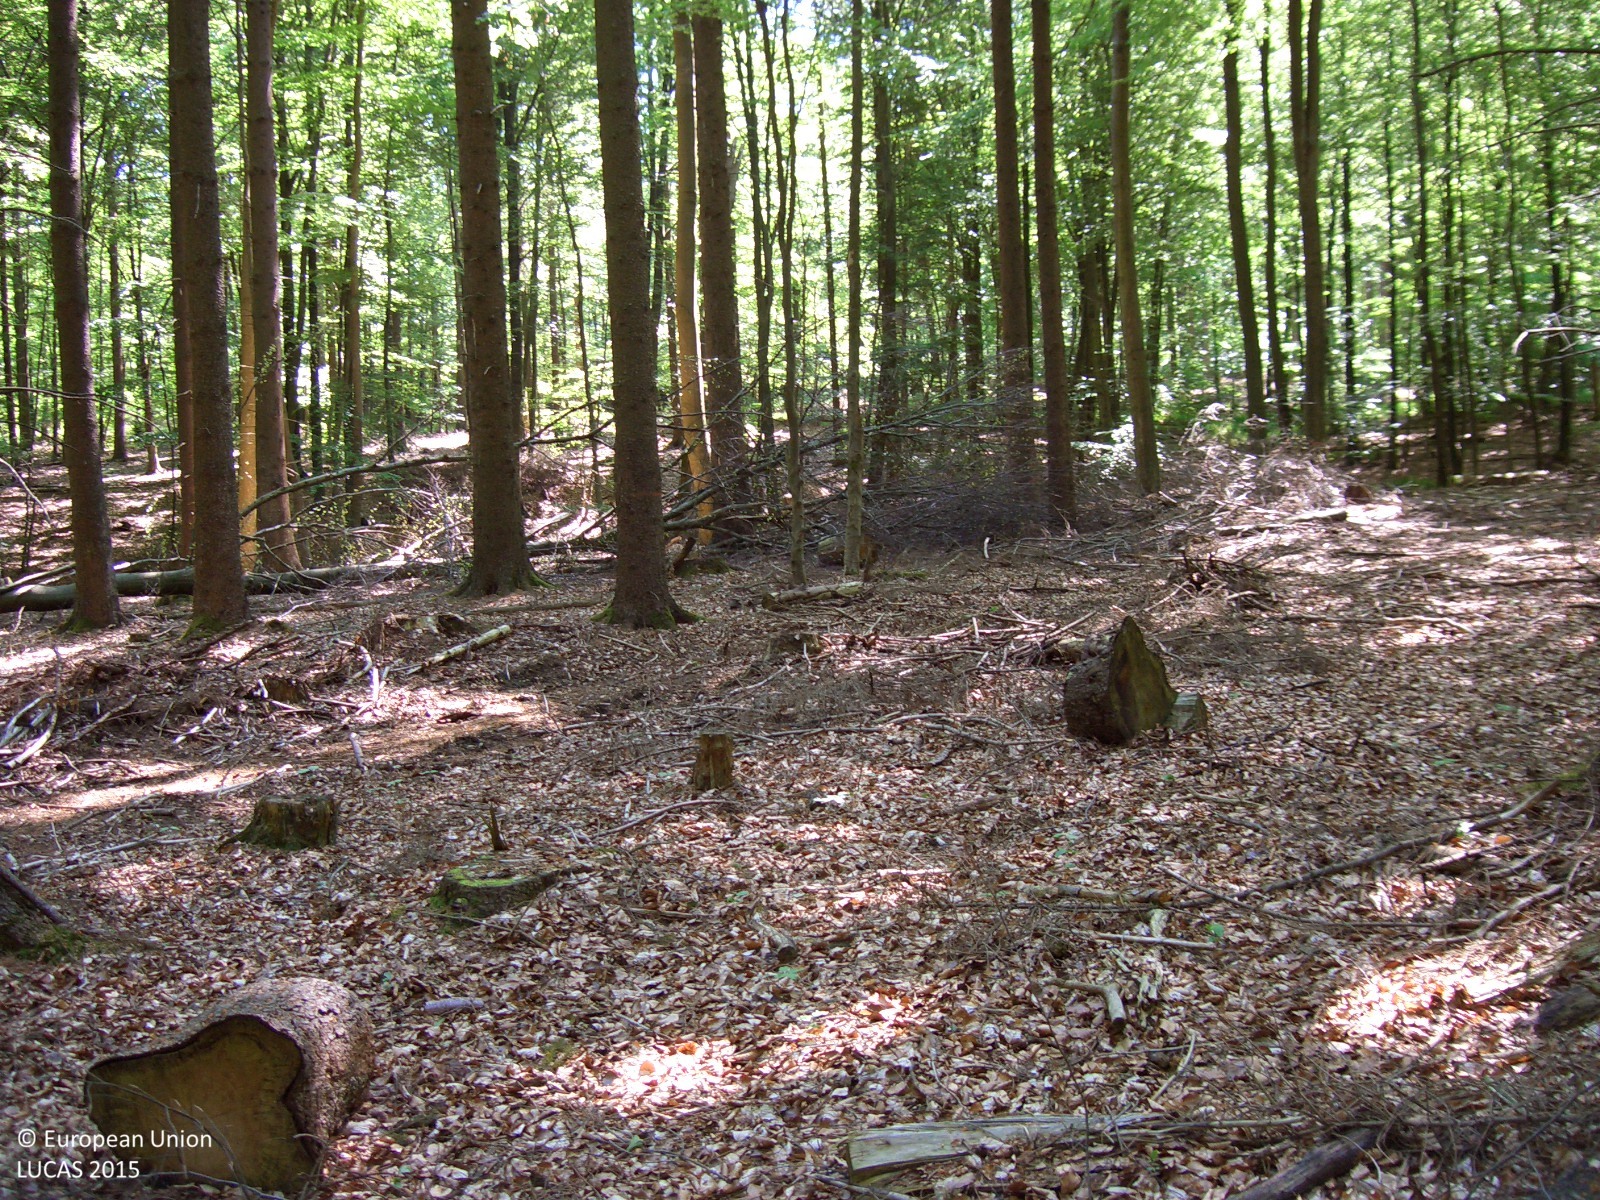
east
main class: Woodland
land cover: Spruce dominated mixed woodland
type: beech forest
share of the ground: > 75 %
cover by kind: broadleaved forest trees 70 %, coniferous forest trees 30 %
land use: Forestry
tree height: > 5 m
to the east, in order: Spruce dominated mixed woodland; Spruce dominated coniferous woodland
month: June
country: DE
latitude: 50.6985
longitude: 6.2475
